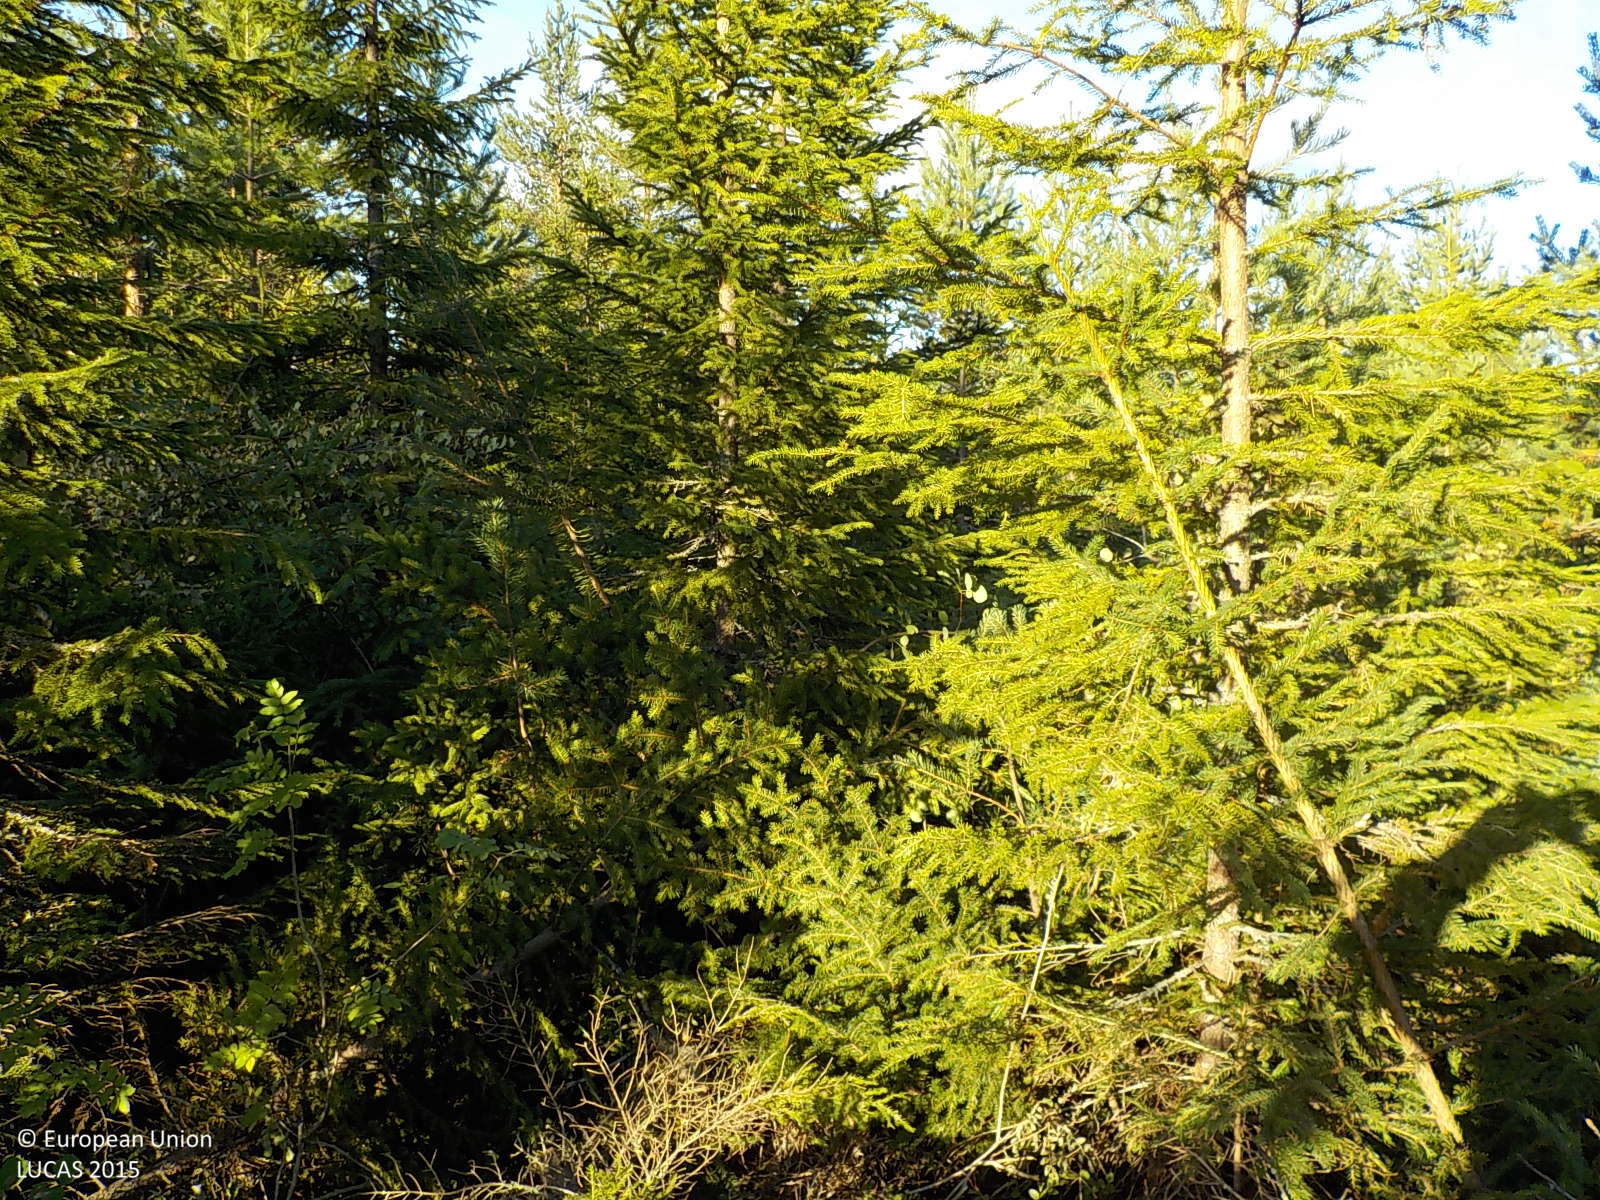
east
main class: Woodland
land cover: Other coniferous woodland
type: boreal forest
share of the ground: > 75 %
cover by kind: coniferous forest trees 80 %, shrubs 15 %, broadleaved forest trees 5 %
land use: Forestry
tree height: > 5 m
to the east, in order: Other coniferous woodland; Ditches and canals; Pine dominated coniferous woodland; Spruce dominated mixed woodland
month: August
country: SE
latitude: 63.4078
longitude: 18.8080
